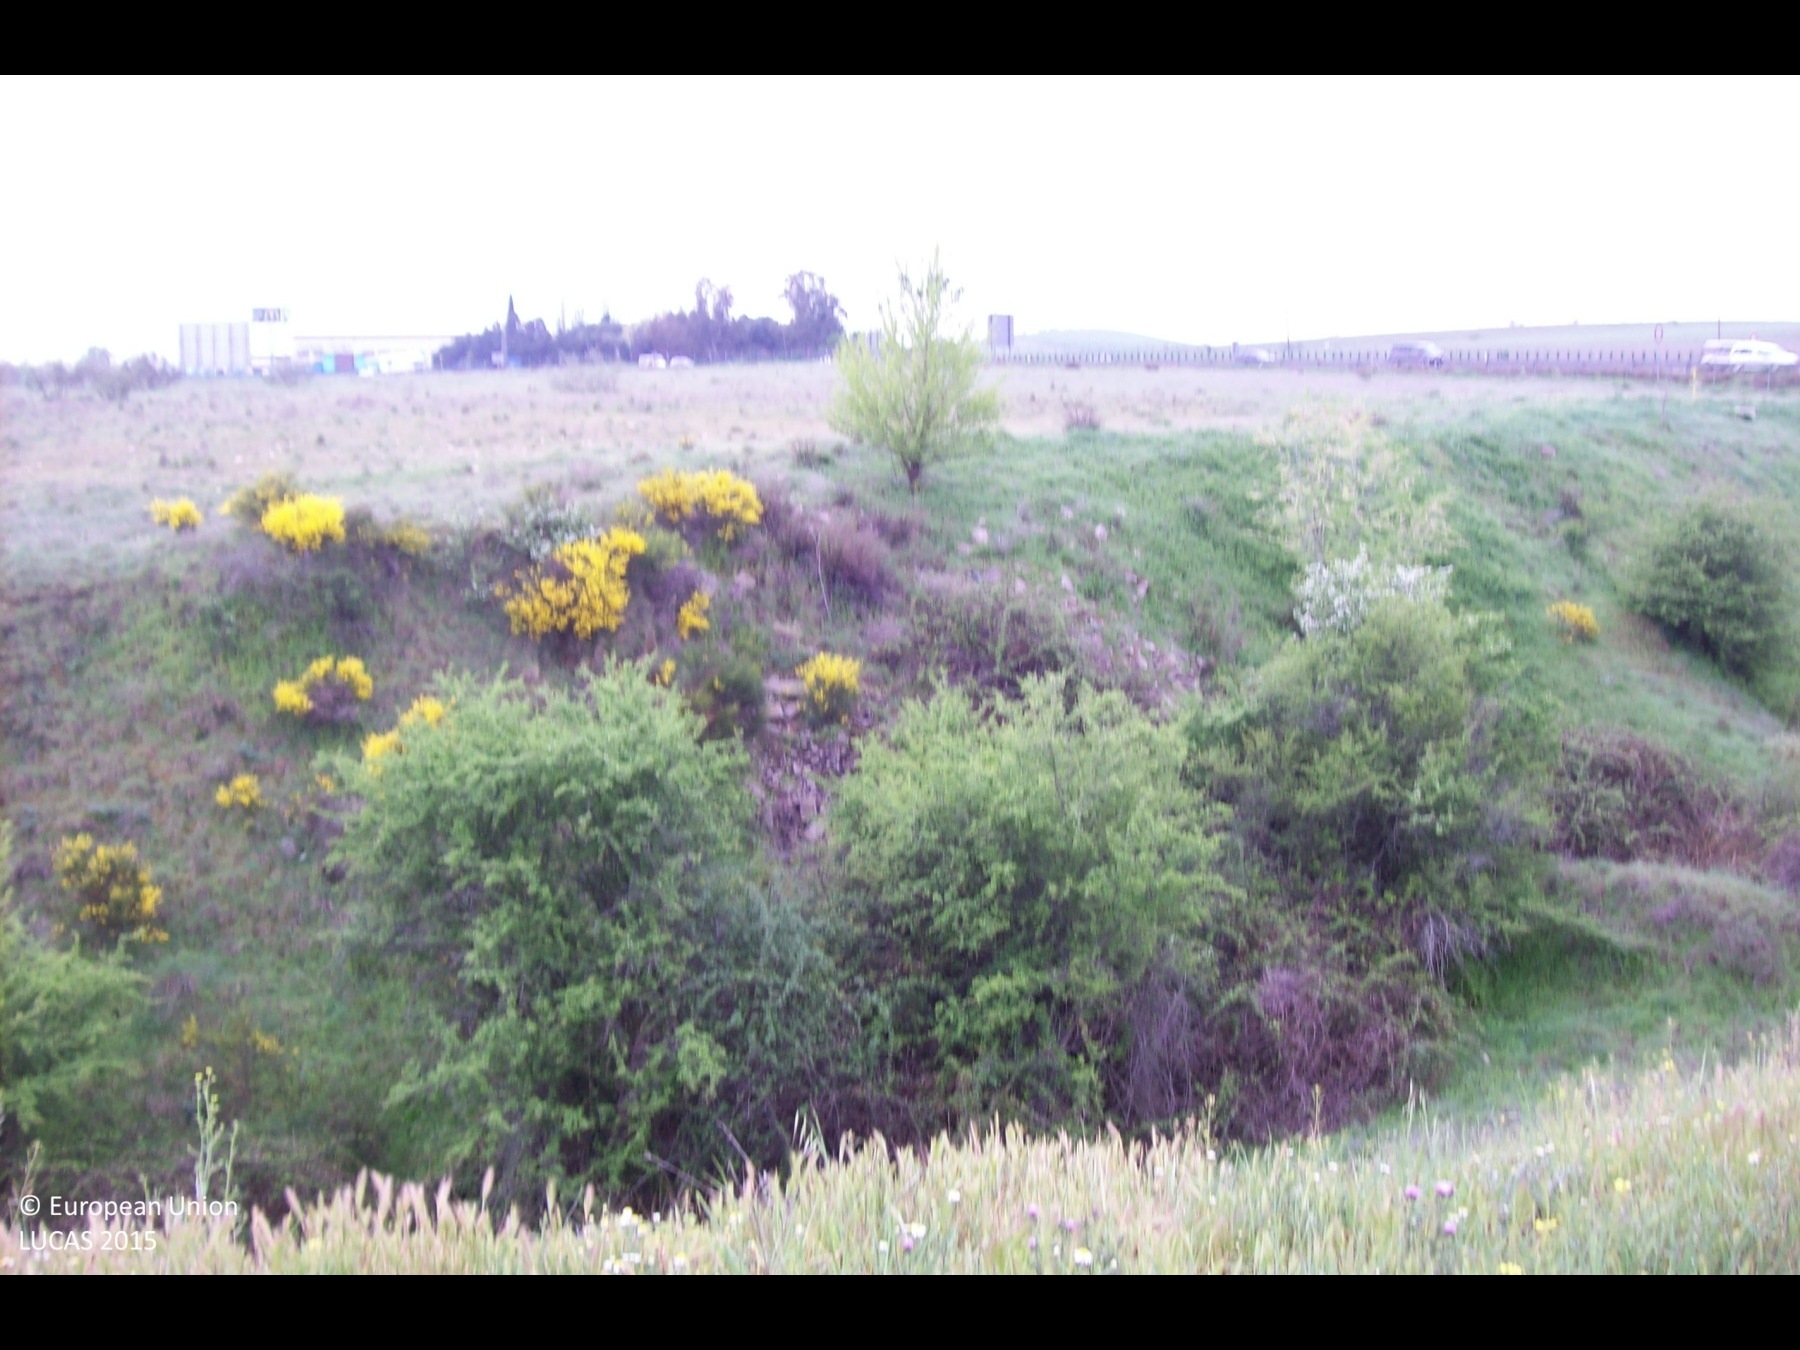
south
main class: Grassland
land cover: Grassland without tree/shrub cover
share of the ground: > 75 %
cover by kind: herbaceous plants 100 %
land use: Semi-natural and natural areas not in use
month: April
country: ES
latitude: 40.6696
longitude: -3.6081
